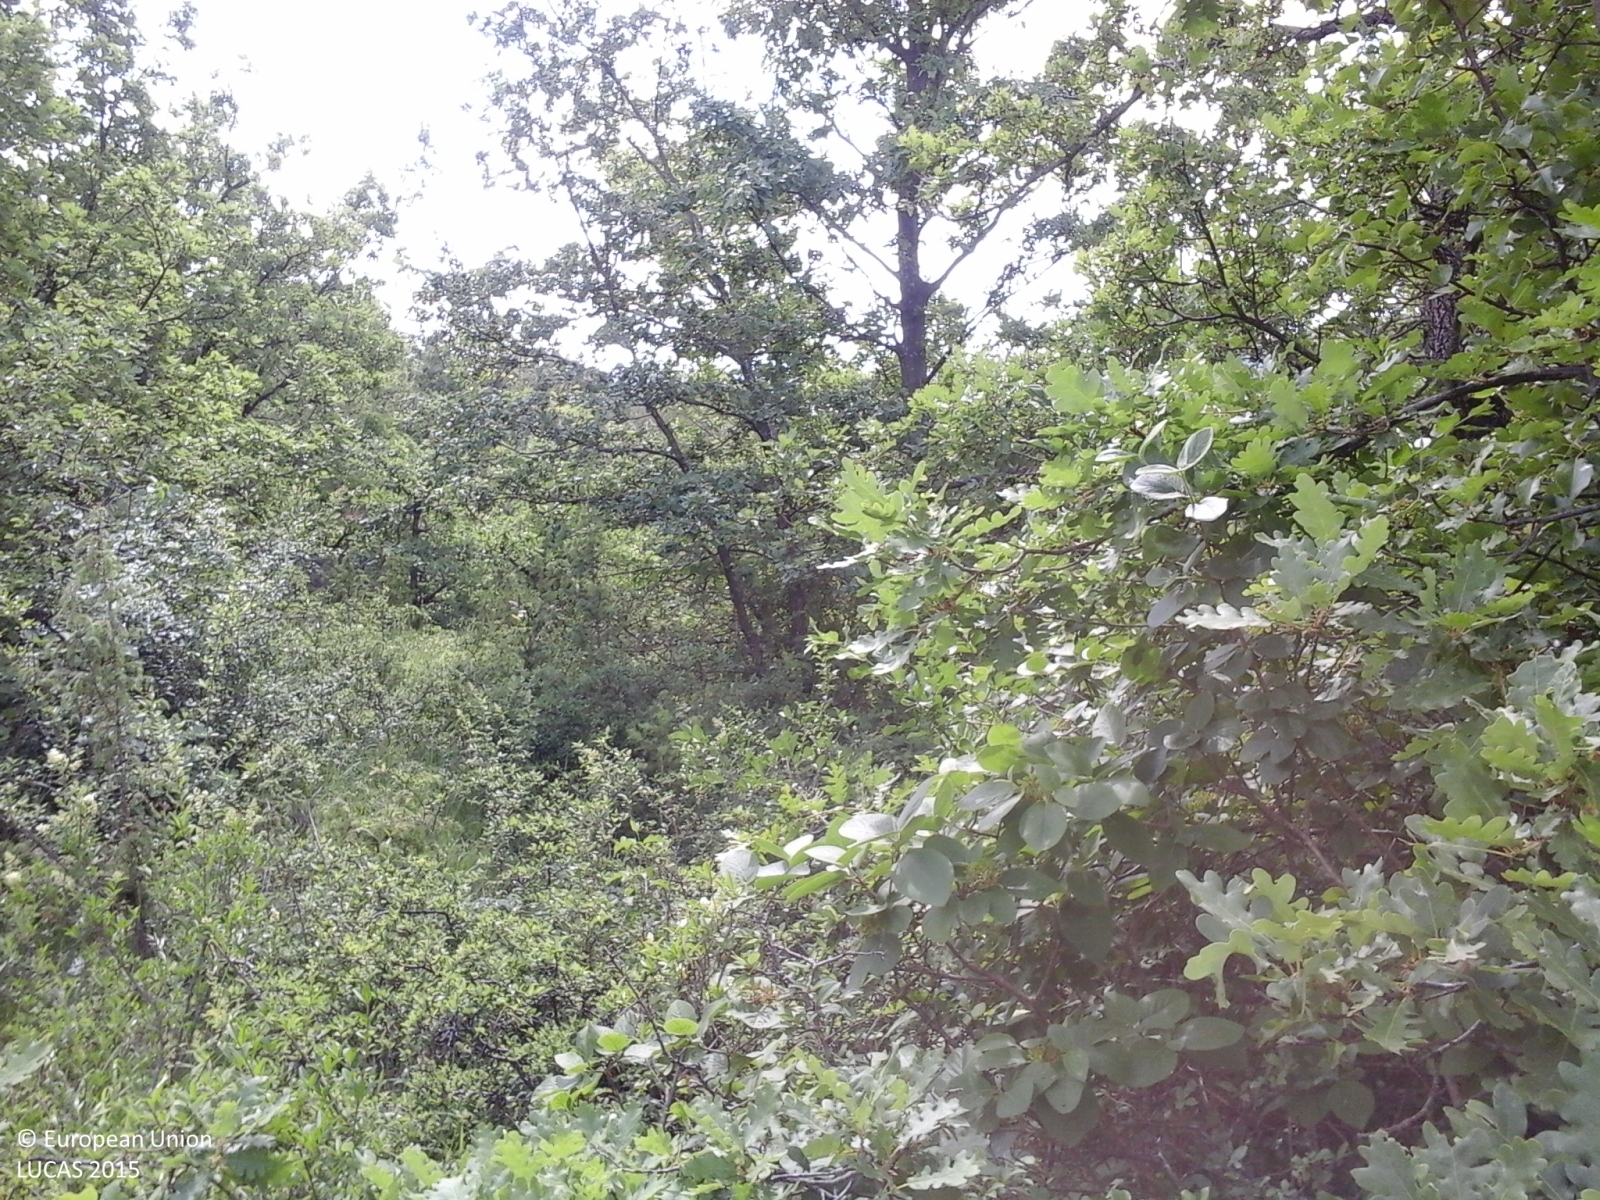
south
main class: Woodland
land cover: Broadleaved woodland
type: thermophilous deciduous forest
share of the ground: 50 - 75 %
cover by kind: broadleaved forest trees 70 %, shrubs 20 %, herbaceous plants 10 %
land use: Forestry
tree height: > 5 m
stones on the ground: < 10 %
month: May
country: IT
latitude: 44.6751
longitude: 9.8867
